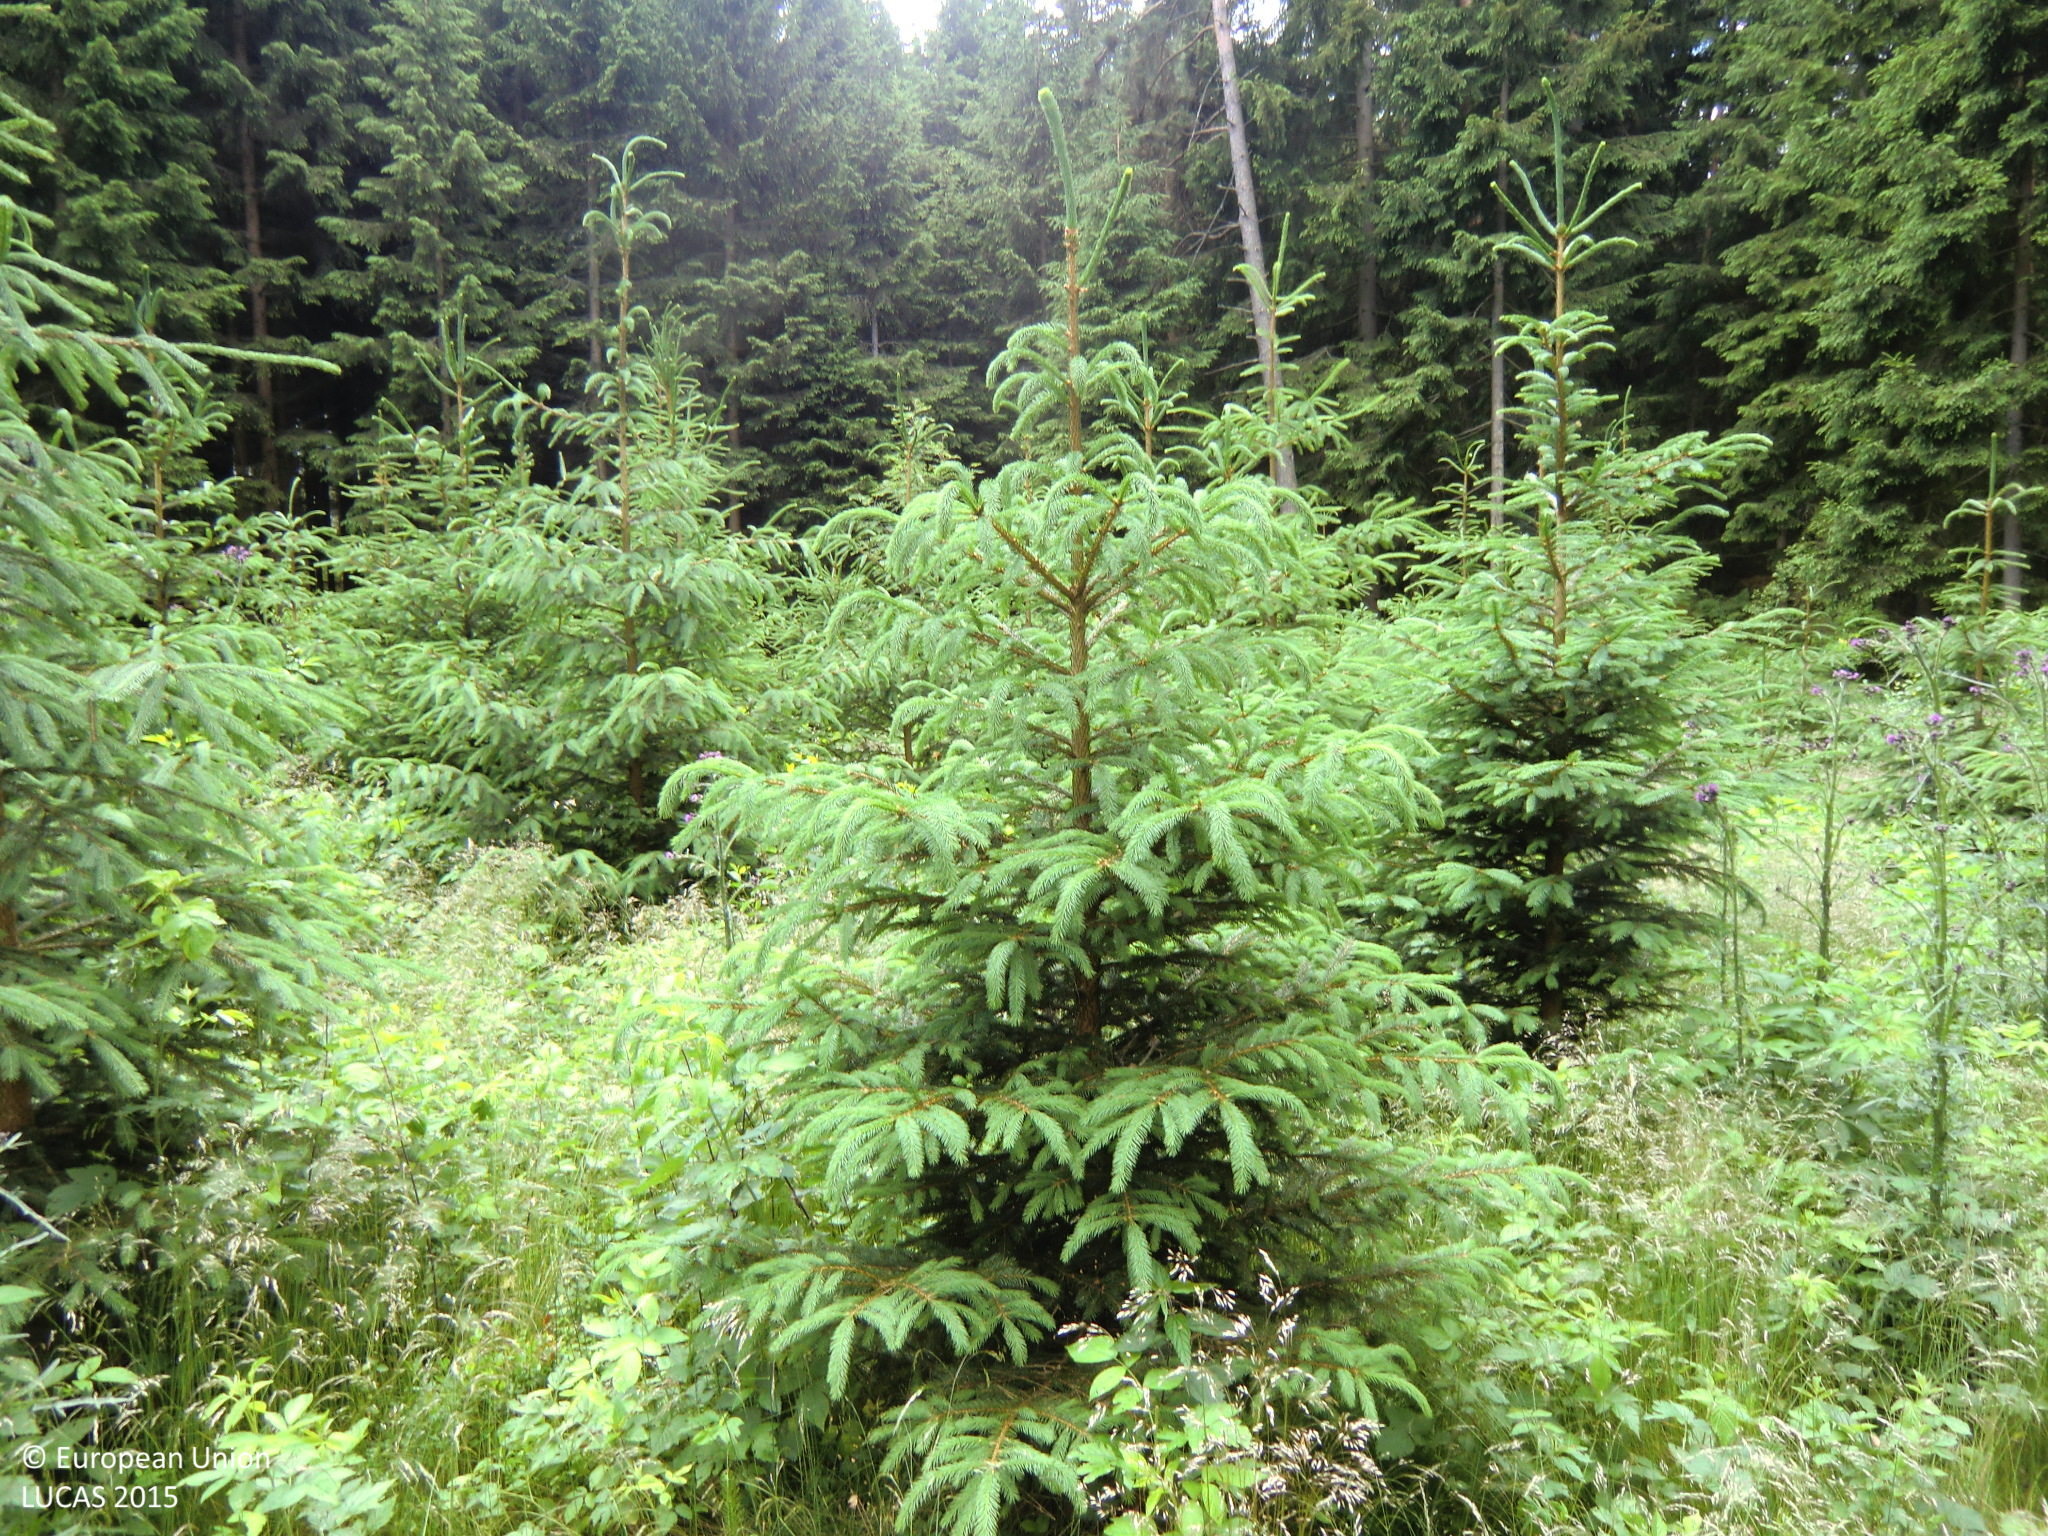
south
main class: Woodland
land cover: Spruce dominated coniferous woodland
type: hemiboreal forest and nemoral coniferous forest and mixed broadleaved-coniferous forest
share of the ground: 25 - 50 %
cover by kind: herbaceous plants 40 %, coniferous forest trees 35 %, shrubs 25 %
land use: Forestry
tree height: < 5 m
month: June
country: AT
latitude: 48.5261
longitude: 14.9710
